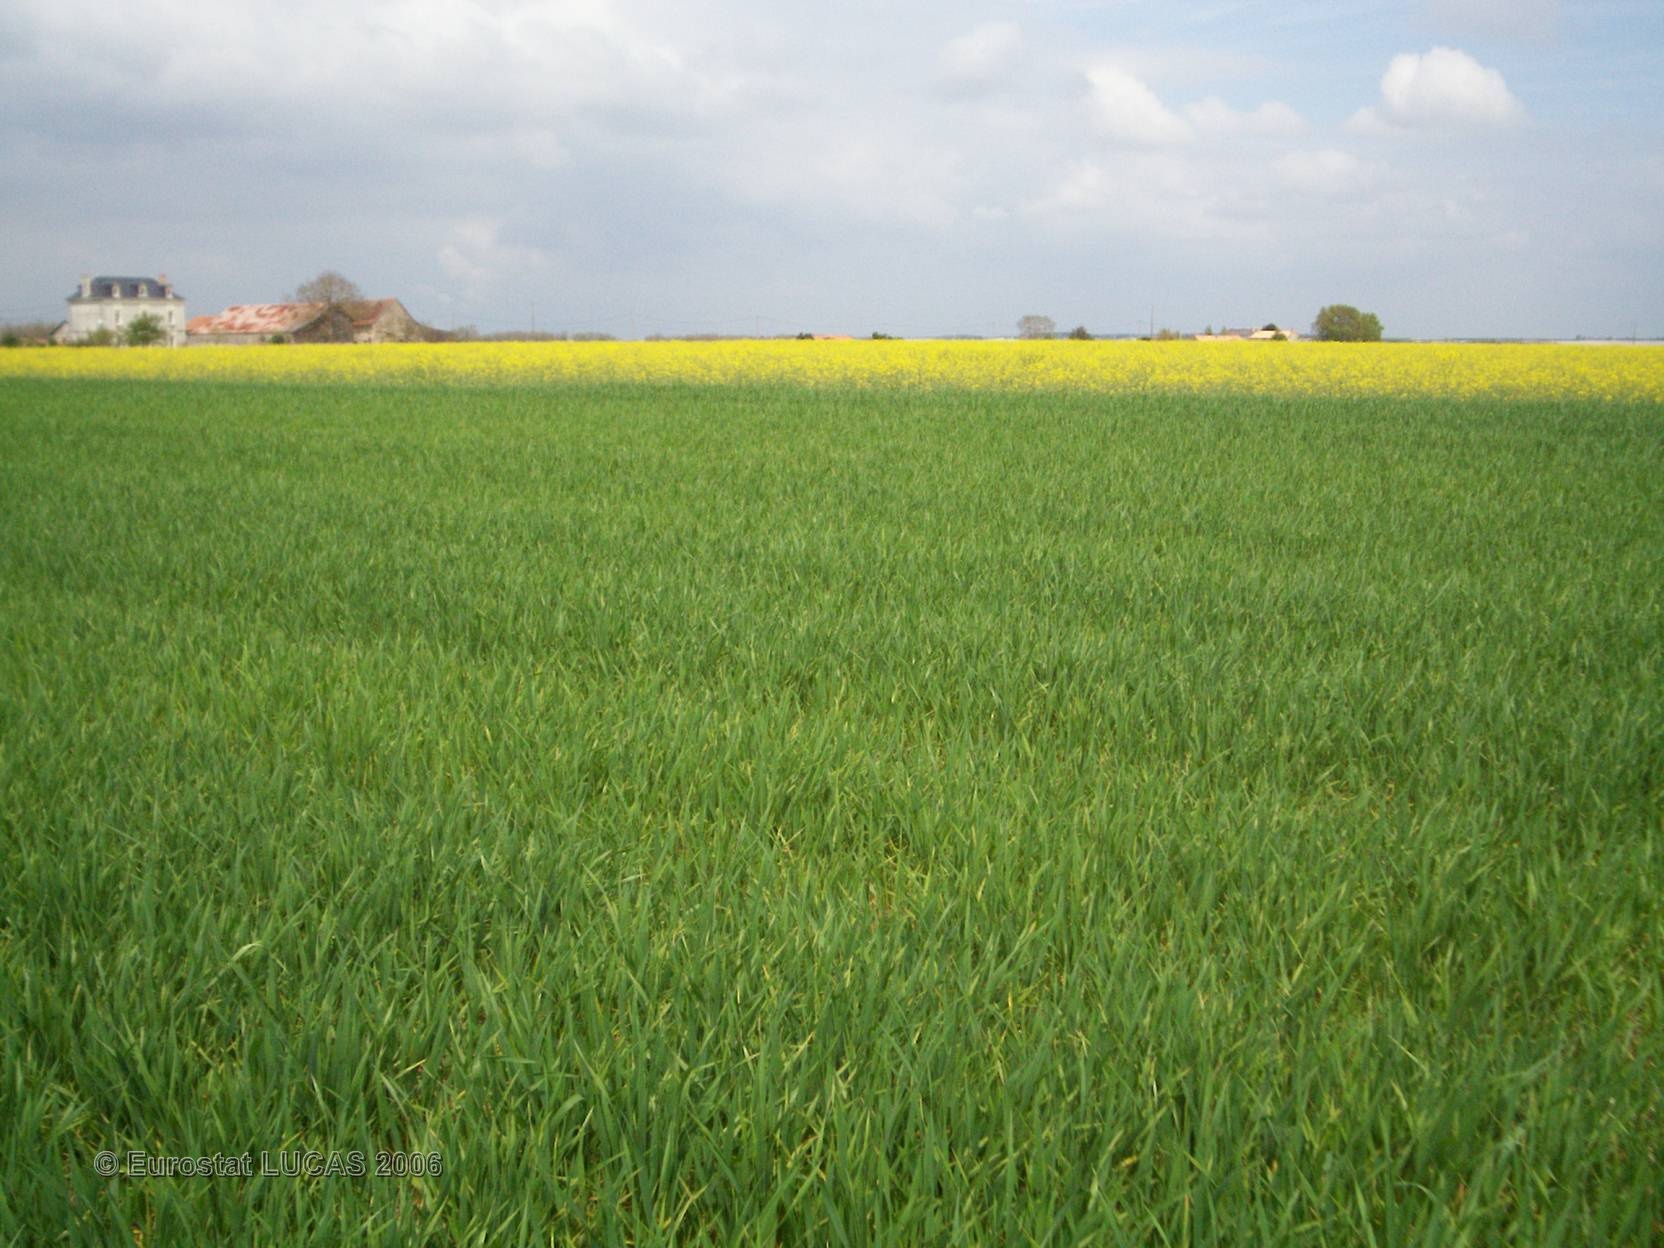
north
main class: Cropland
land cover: Barley
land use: Agriculture (excluding fallow land and kitchen gardens)
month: April
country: FR
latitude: 47.0449
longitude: 0.2248
